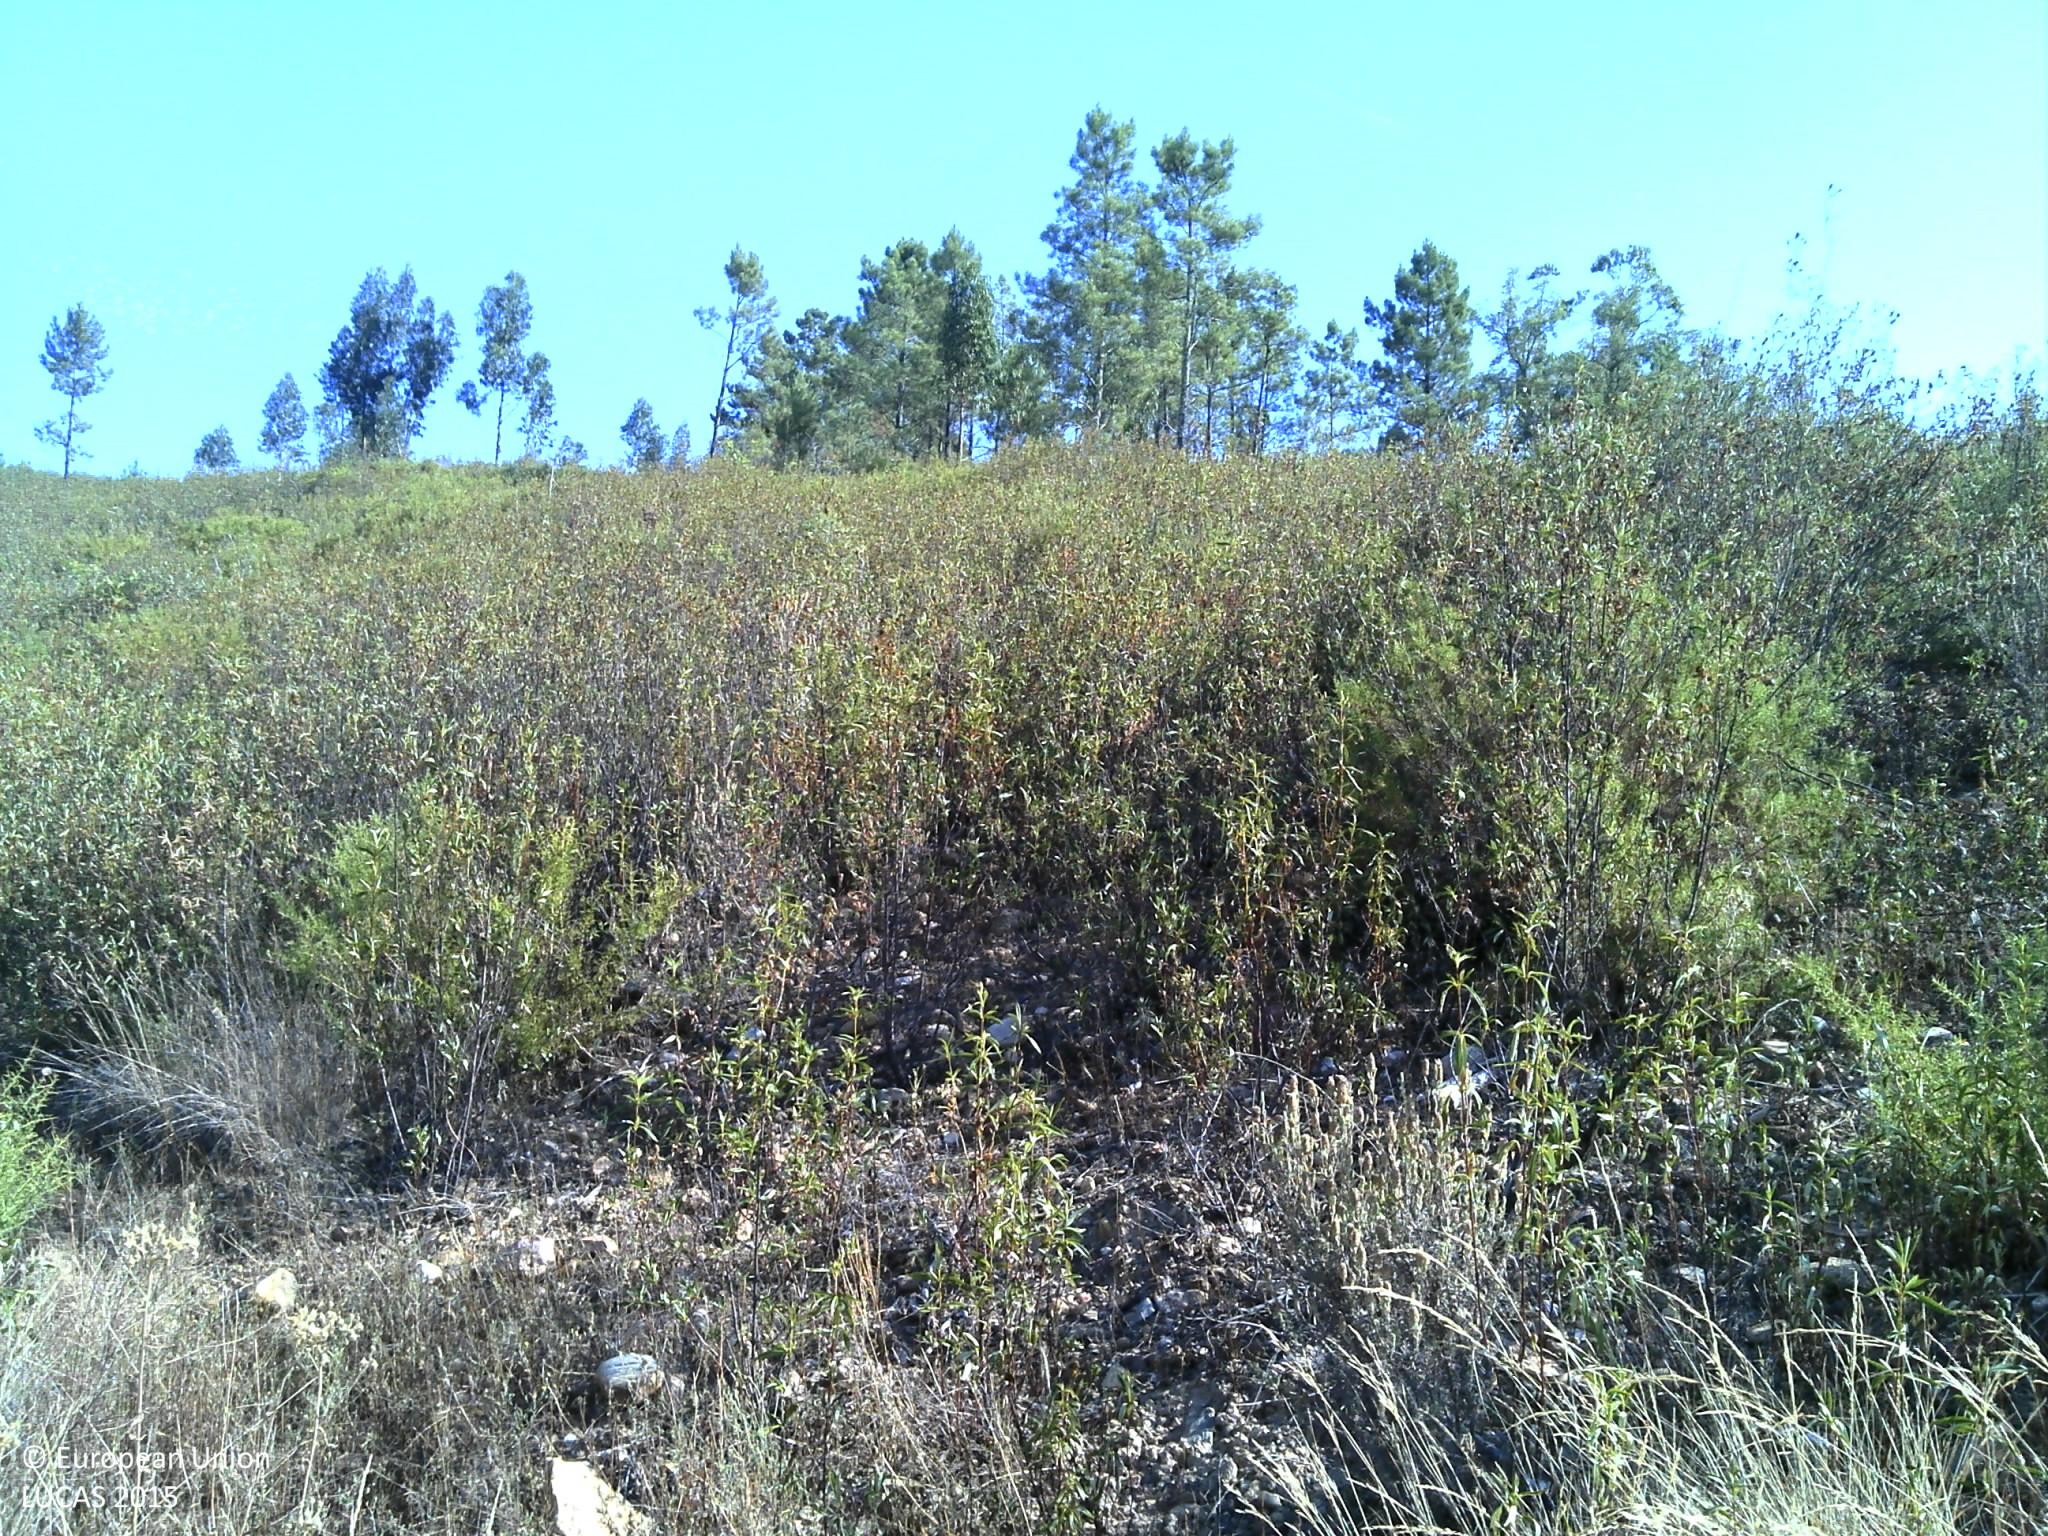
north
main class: Shrubland
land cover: Shrubland with sparse tree cover
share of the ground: > 75 %
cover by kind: shrubs 80 %, unconsolidated bare surface 10 %, broadleaved forest trees 5 %, consolidated bare surface 5 %
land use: Abandoned areas
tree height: > 5 m
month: July
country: PT
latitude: 39.5015
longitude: -8.0509
